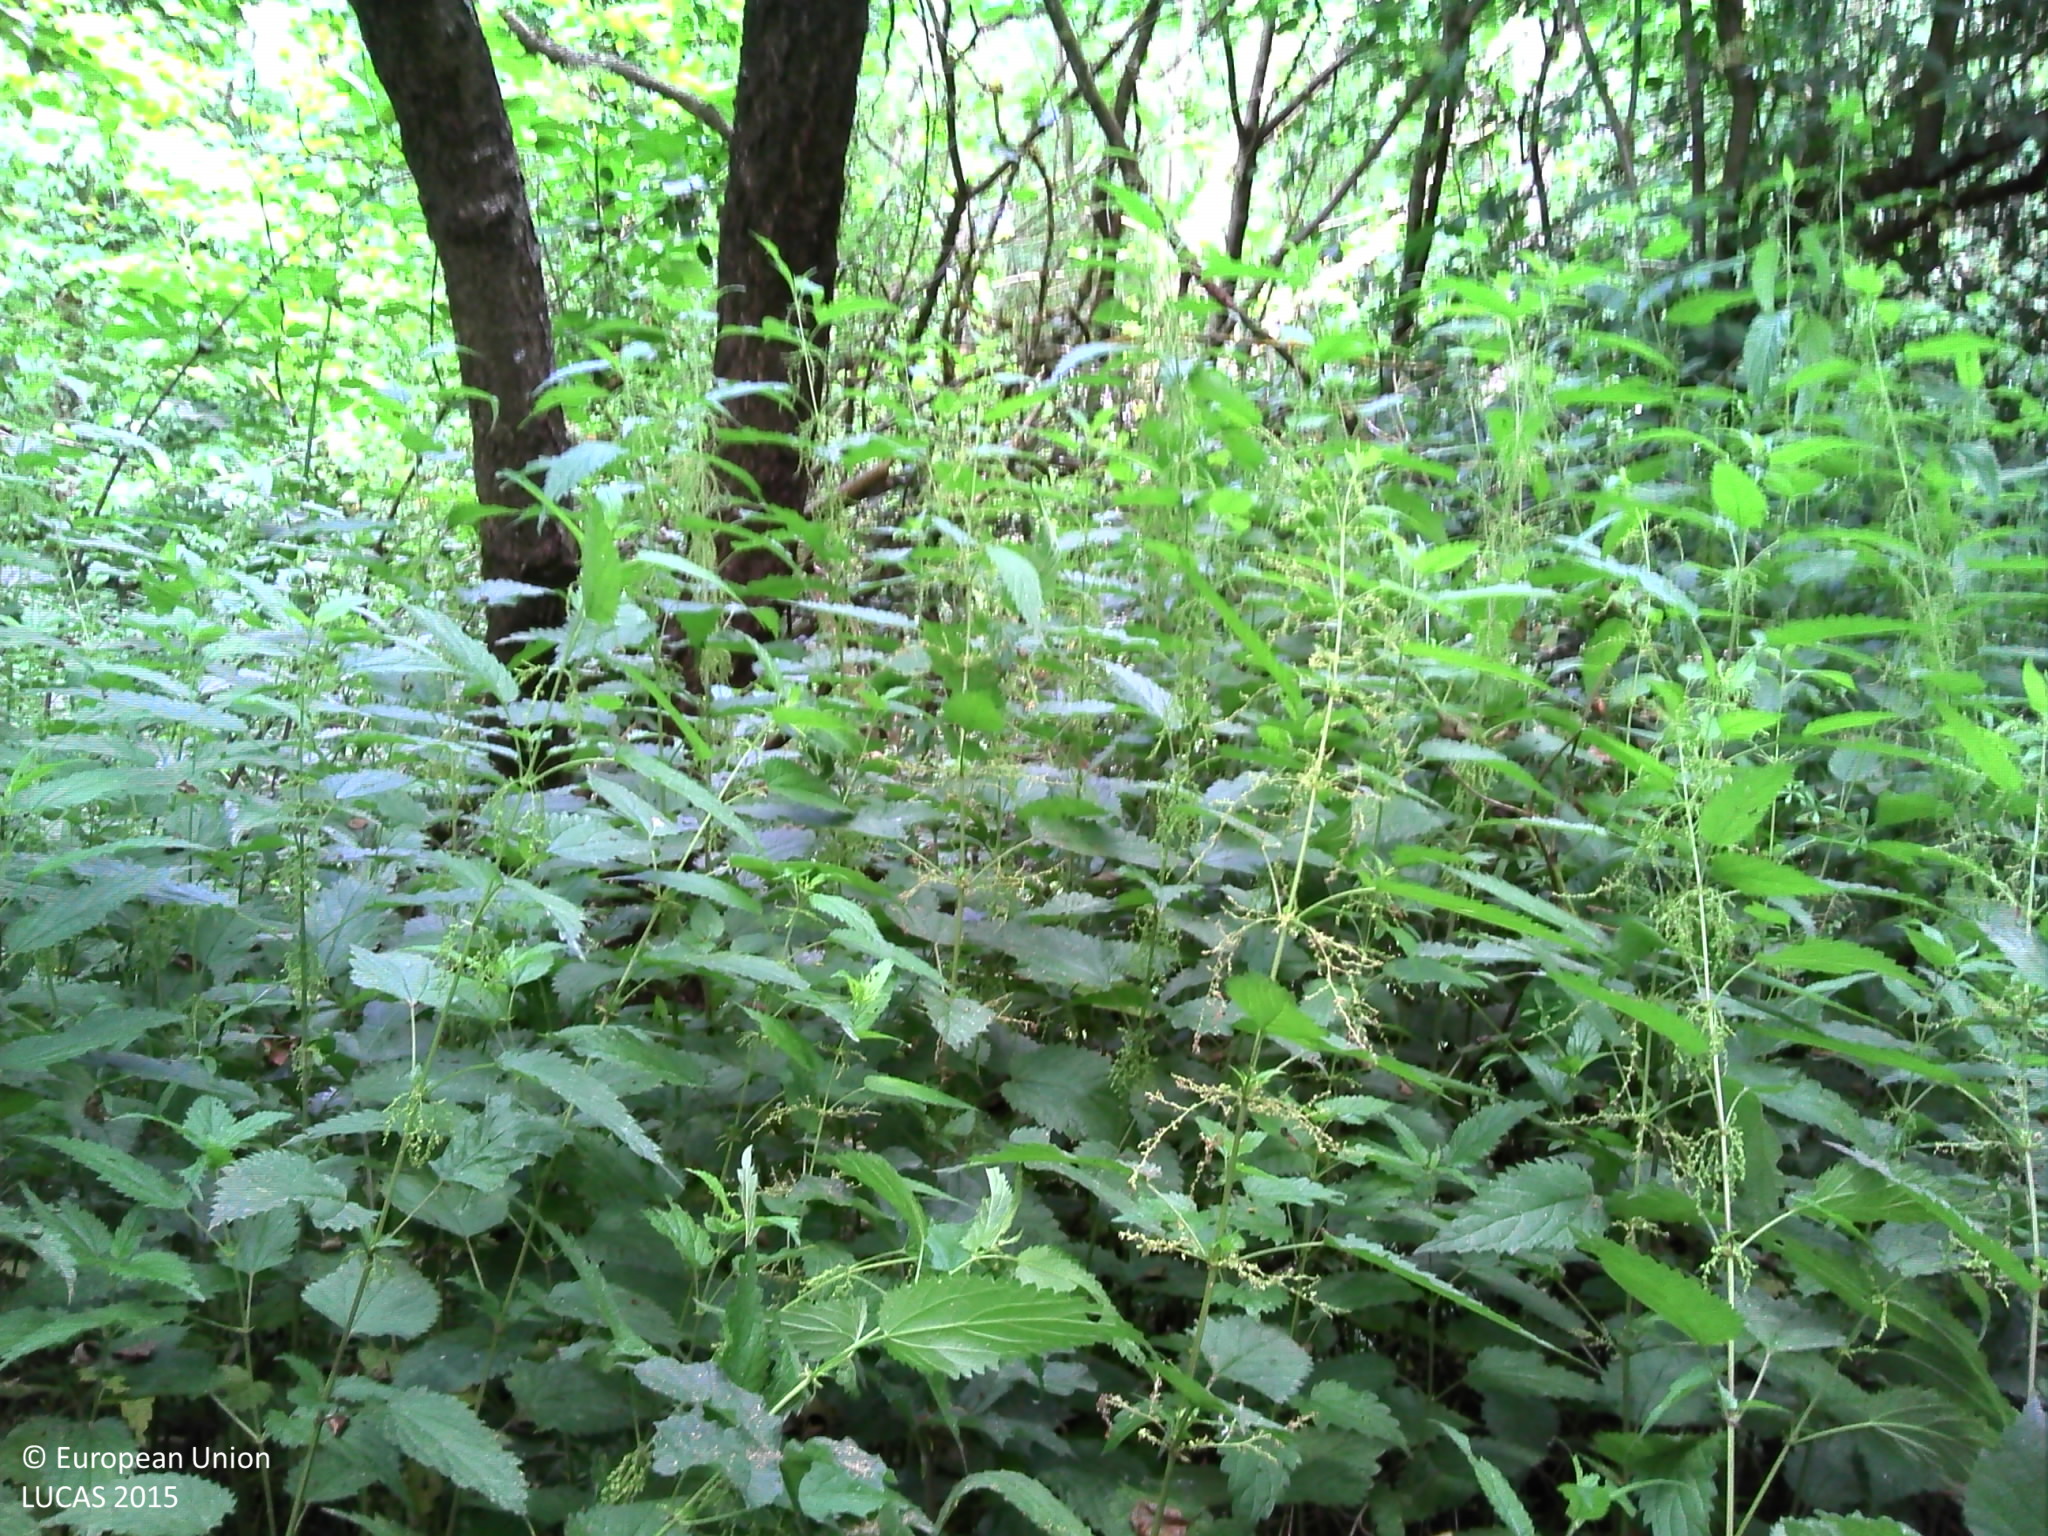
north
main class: Woodland
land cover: Broadleaved woodland
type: floodplain forest
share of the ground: > 75 %
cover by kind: broadleaved forest trees 95 %, herbaceous plants 5 %
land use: Forestry
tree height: > 5 m
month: July
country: BE
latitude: 50.2750
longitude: 4.6503
